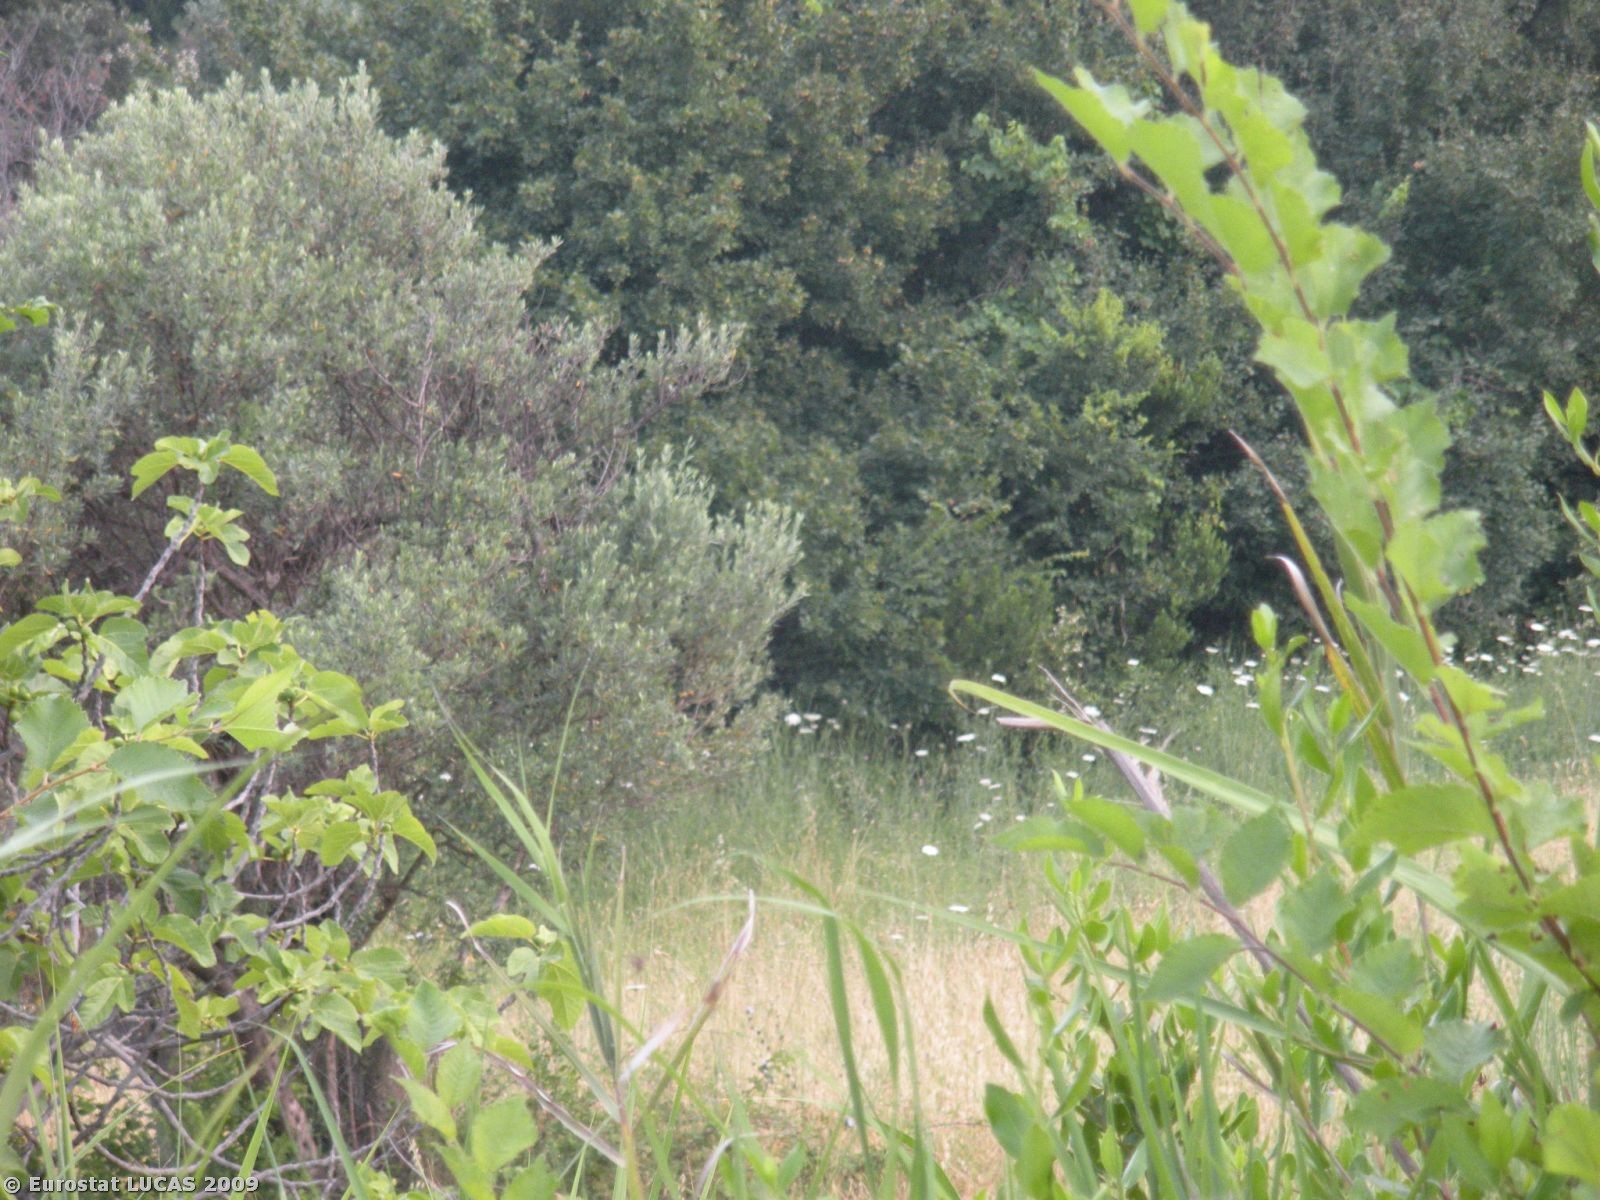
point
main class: Grassland
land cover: Grassland with sparse tree/shrub cover
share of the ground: > 75 %
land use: Fallow land
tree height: < 5 m
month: July
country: IT
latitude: 40.4269
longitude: 15.0584
